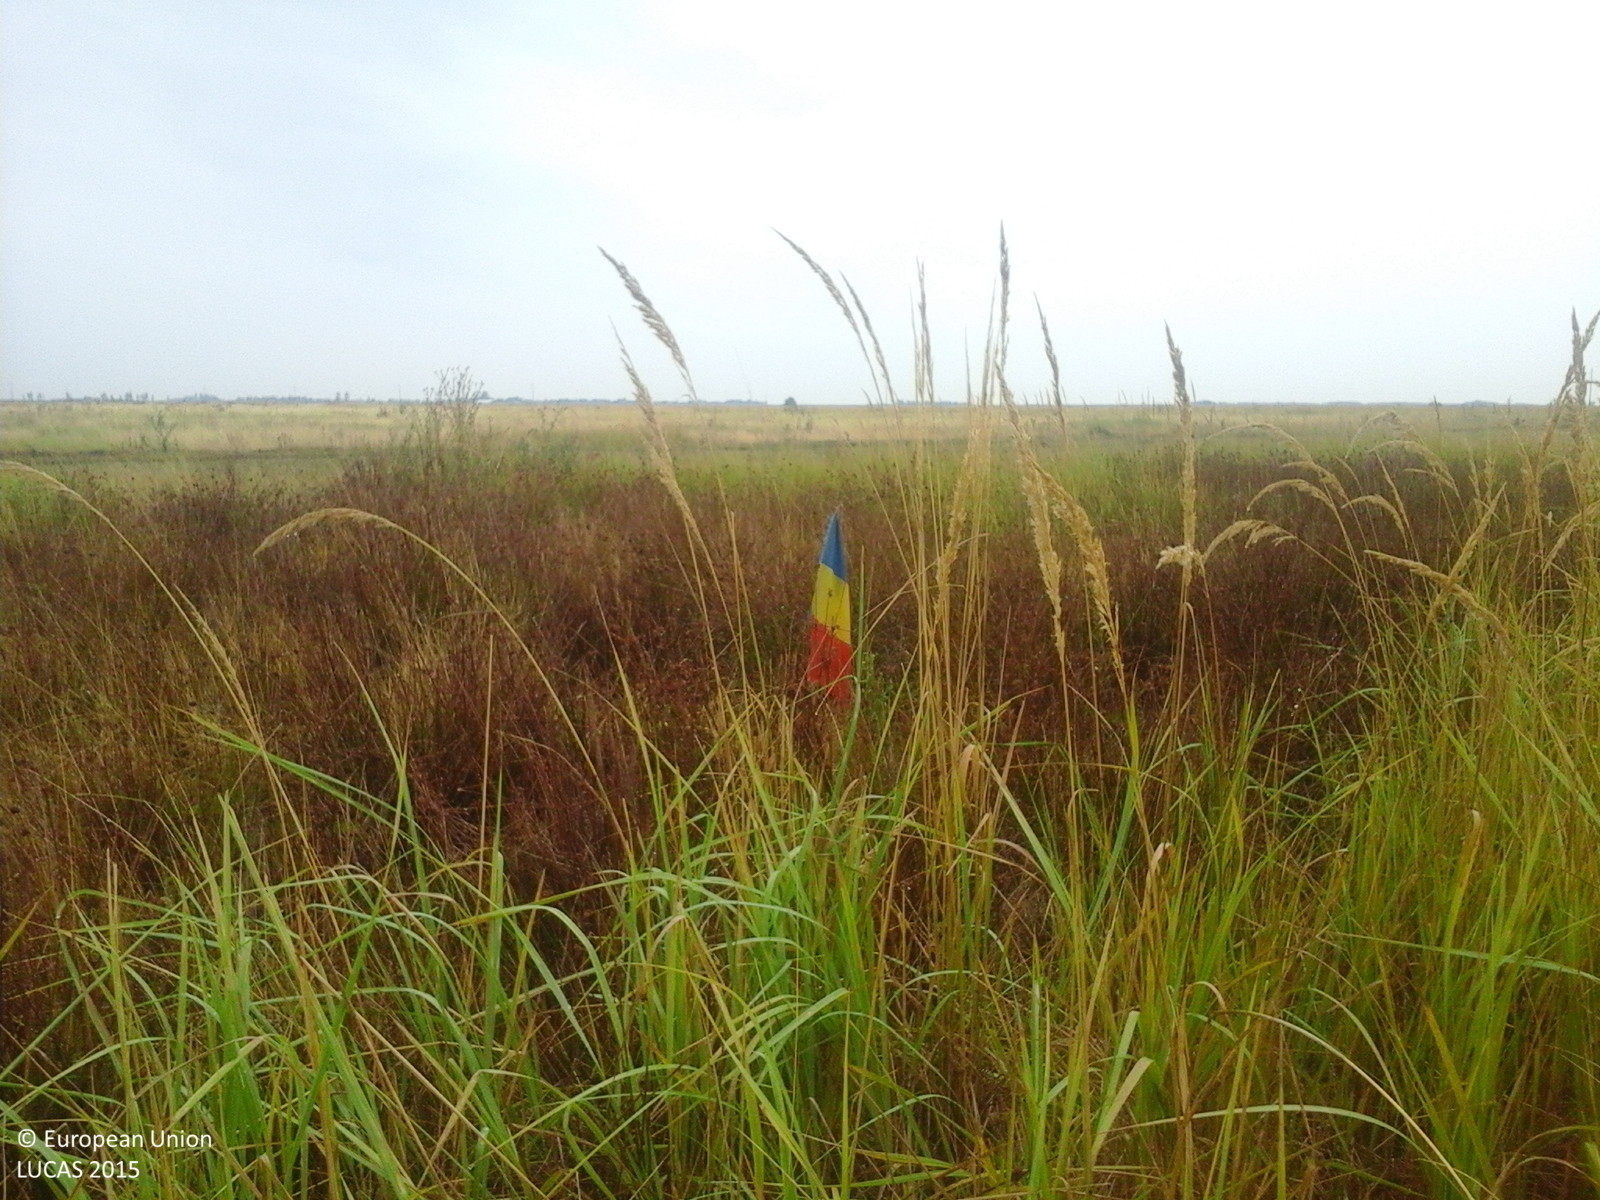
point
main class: Grassland
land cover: Spontaneously vegetated surfaces
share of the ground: > 75 %
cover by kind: herbaceous plants 100 %
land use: Fallow land
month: September
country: RO
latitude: 47.5737
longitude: 22.5679
